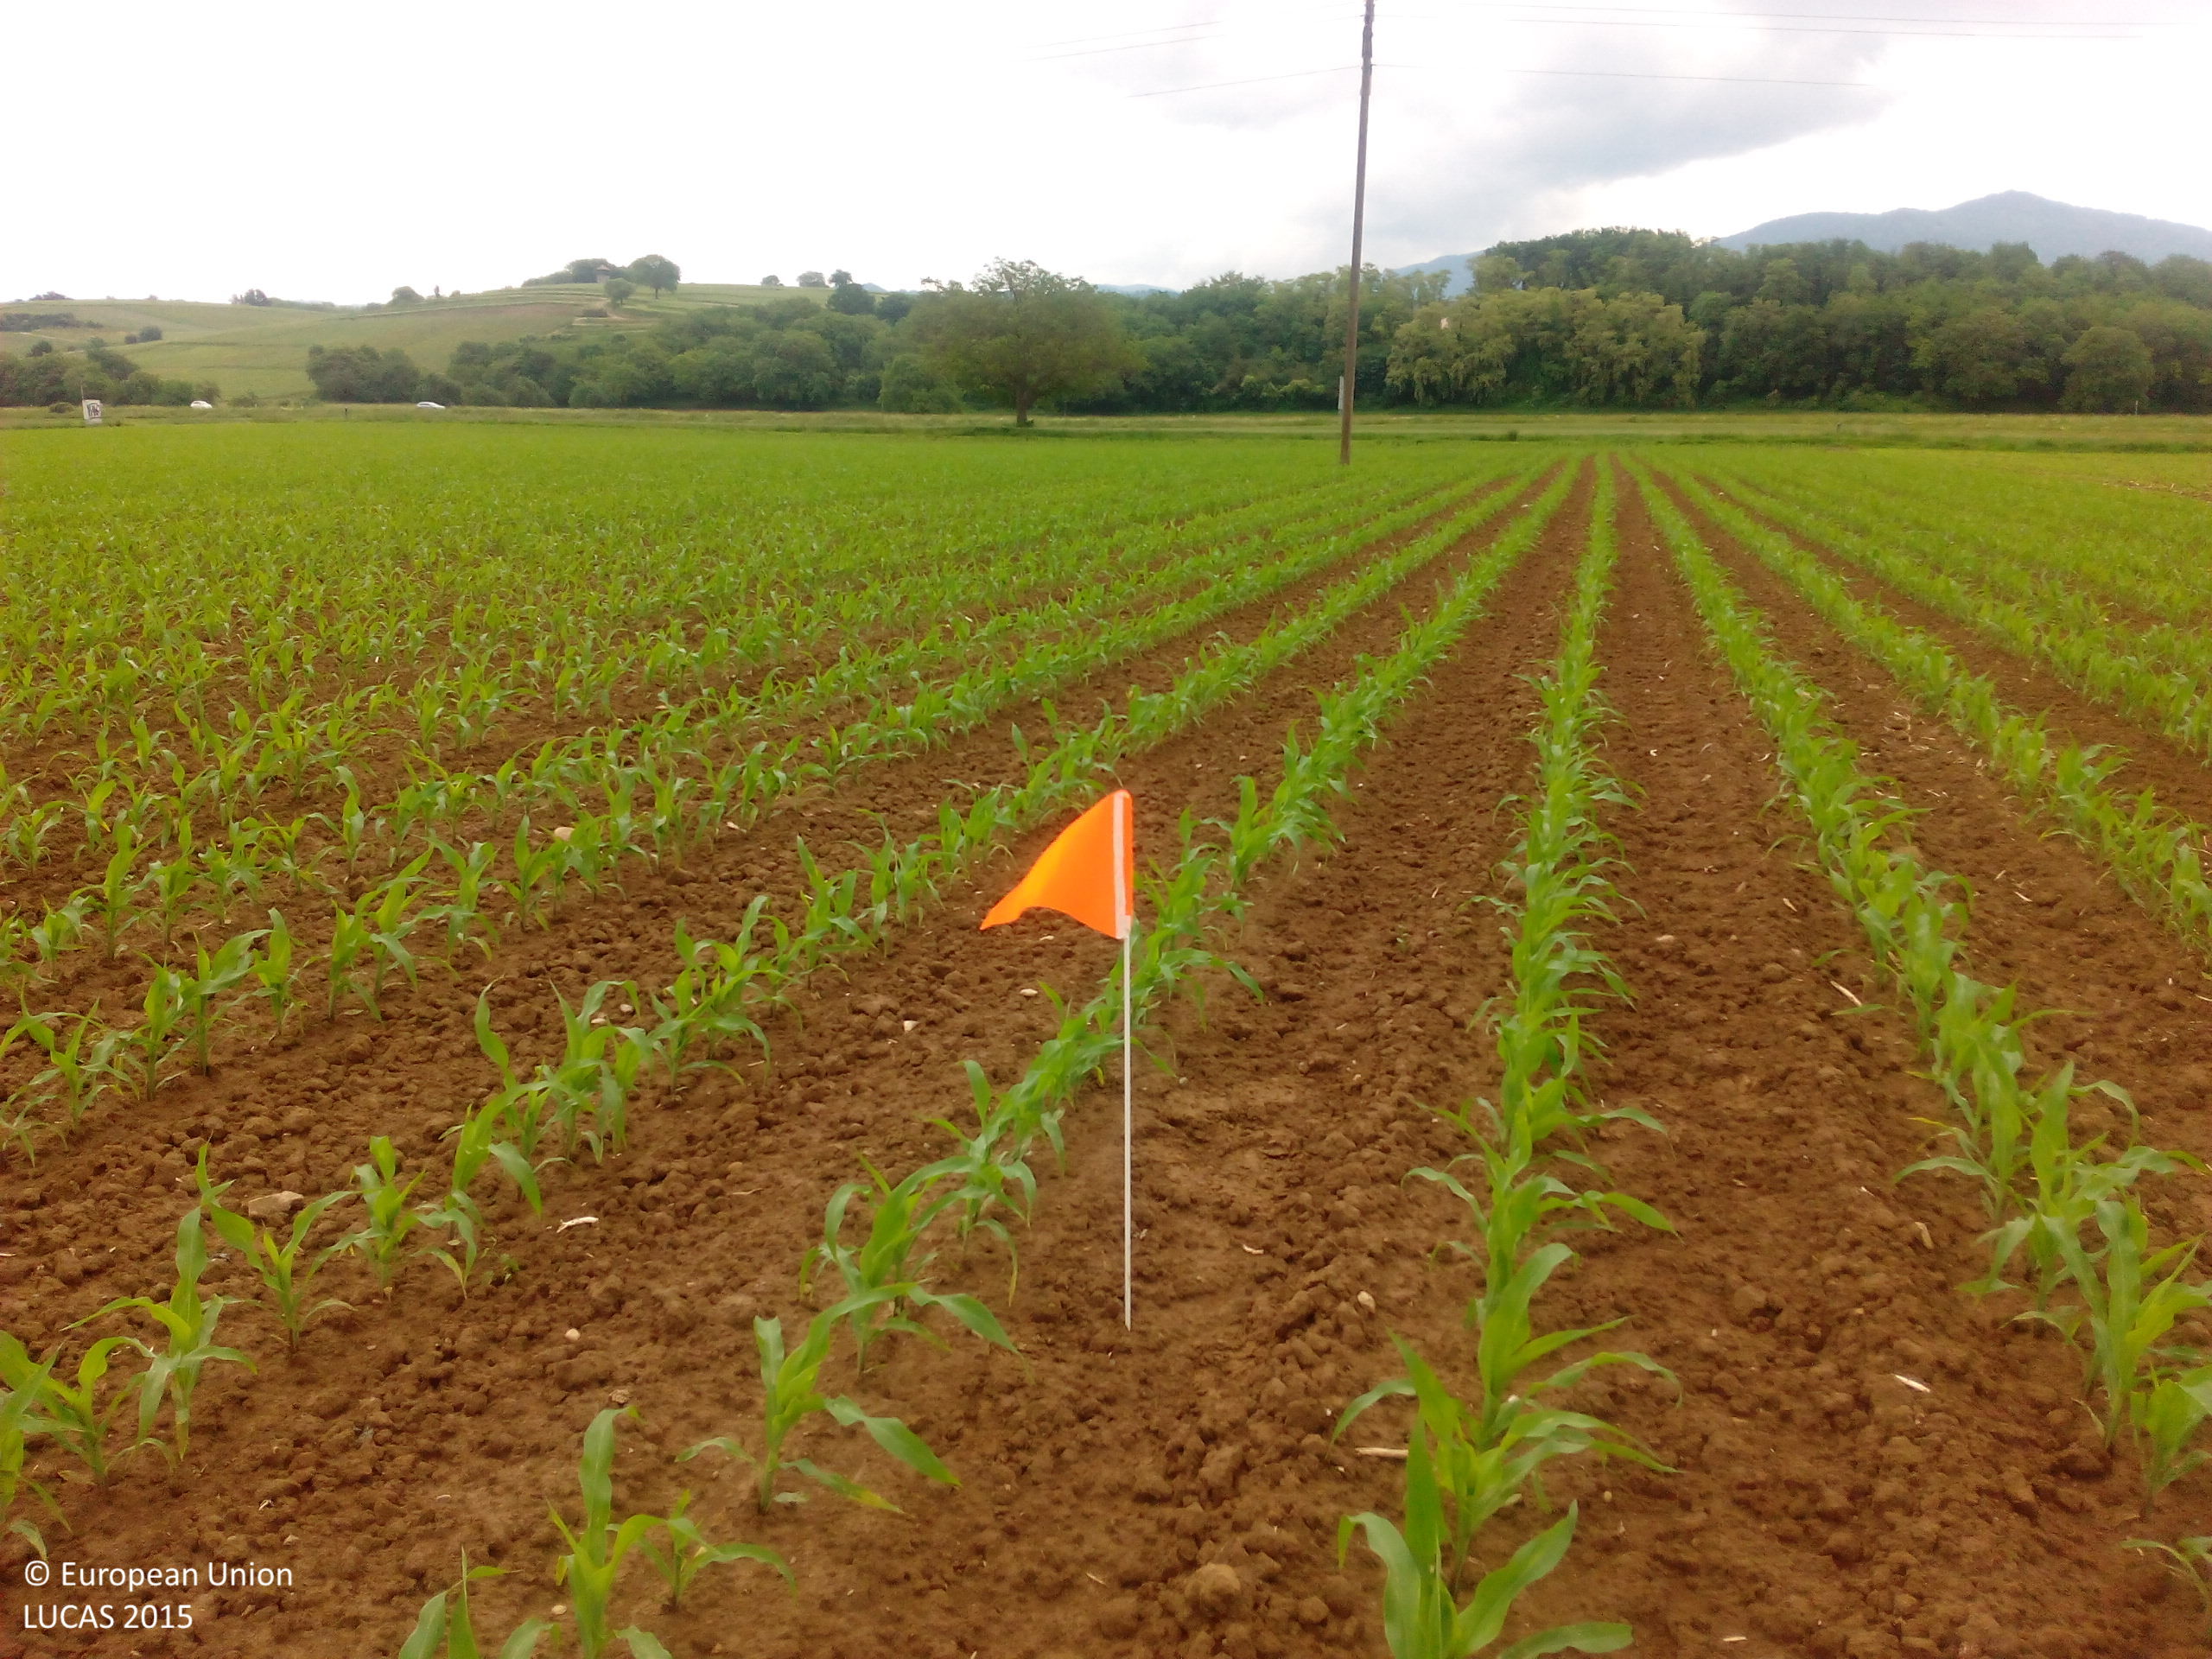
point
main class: Cropland
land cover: Maize
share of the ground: 25 - 50 %
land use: Agriculture (excluding fallow land and kitchen gardens)
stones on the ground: < 10 %
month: May
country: DE
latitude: 47.8196
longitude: 7.6106
